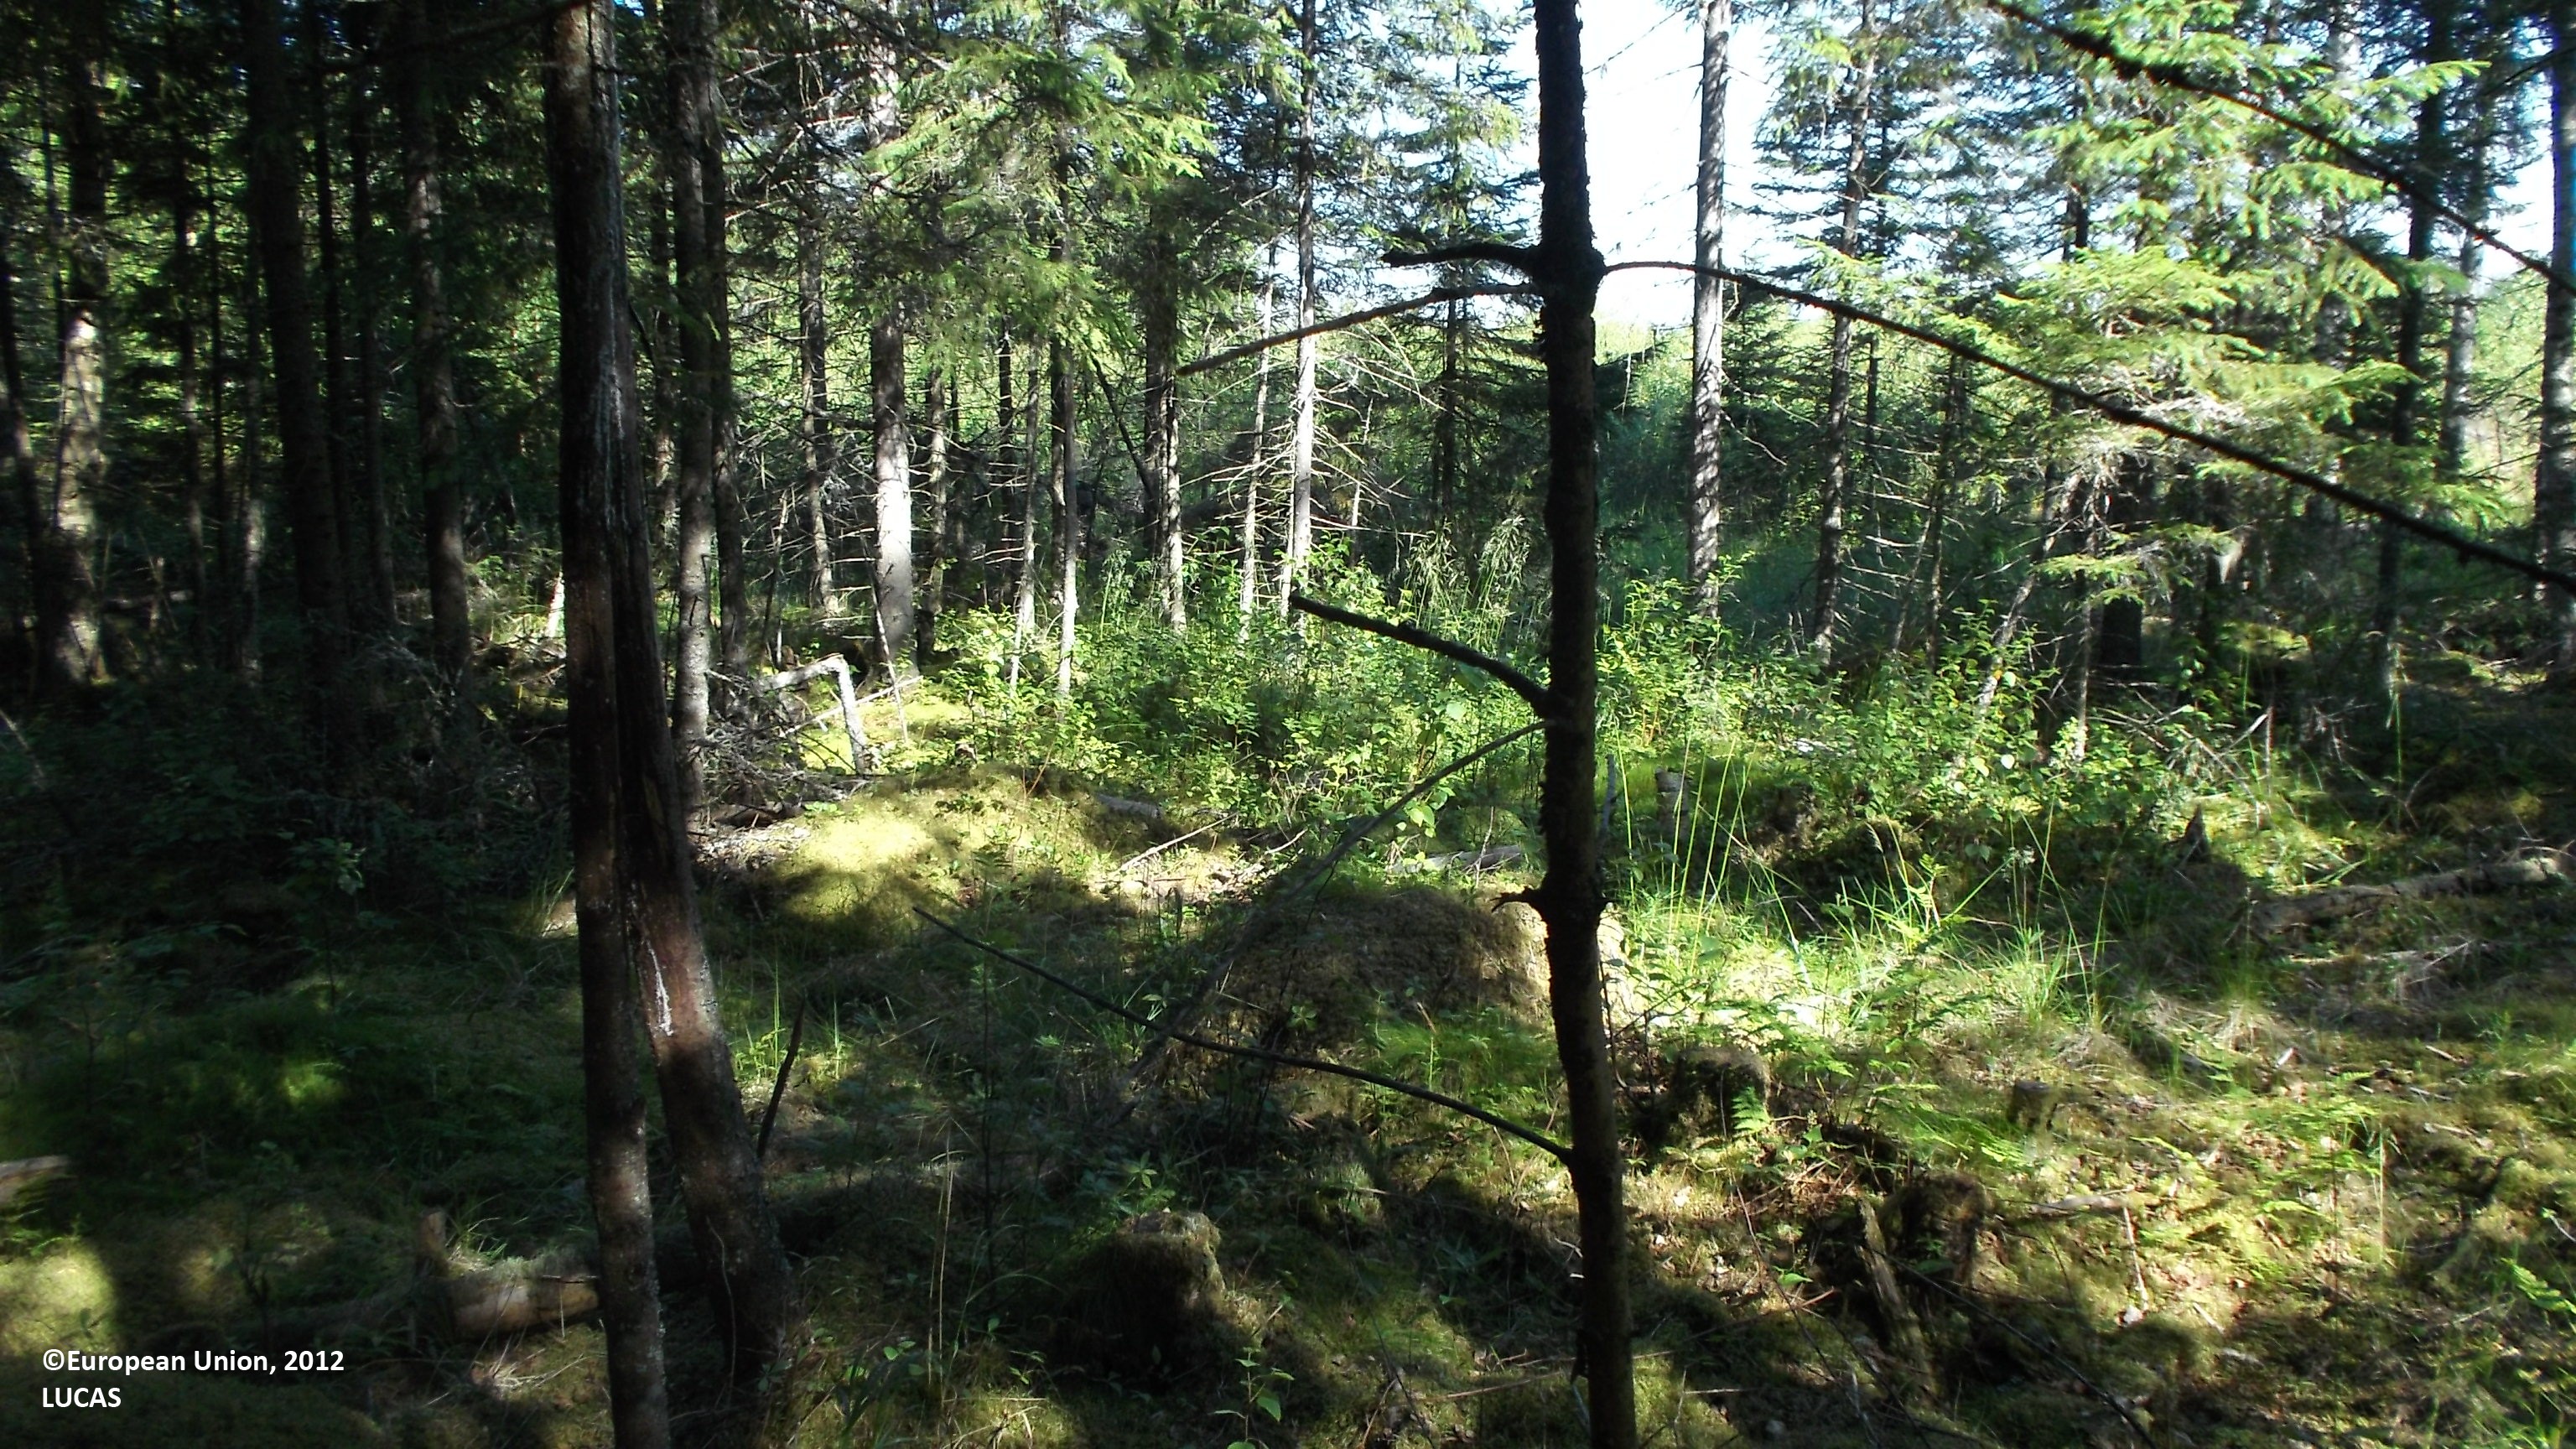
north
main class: Woodland
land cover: Spruce dominated coniferous woodland
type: boreal forest
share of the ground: > 75 %
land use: Forestry
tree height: > 5 m
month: July
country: FI
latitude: 63.8608
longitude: 23.2170
